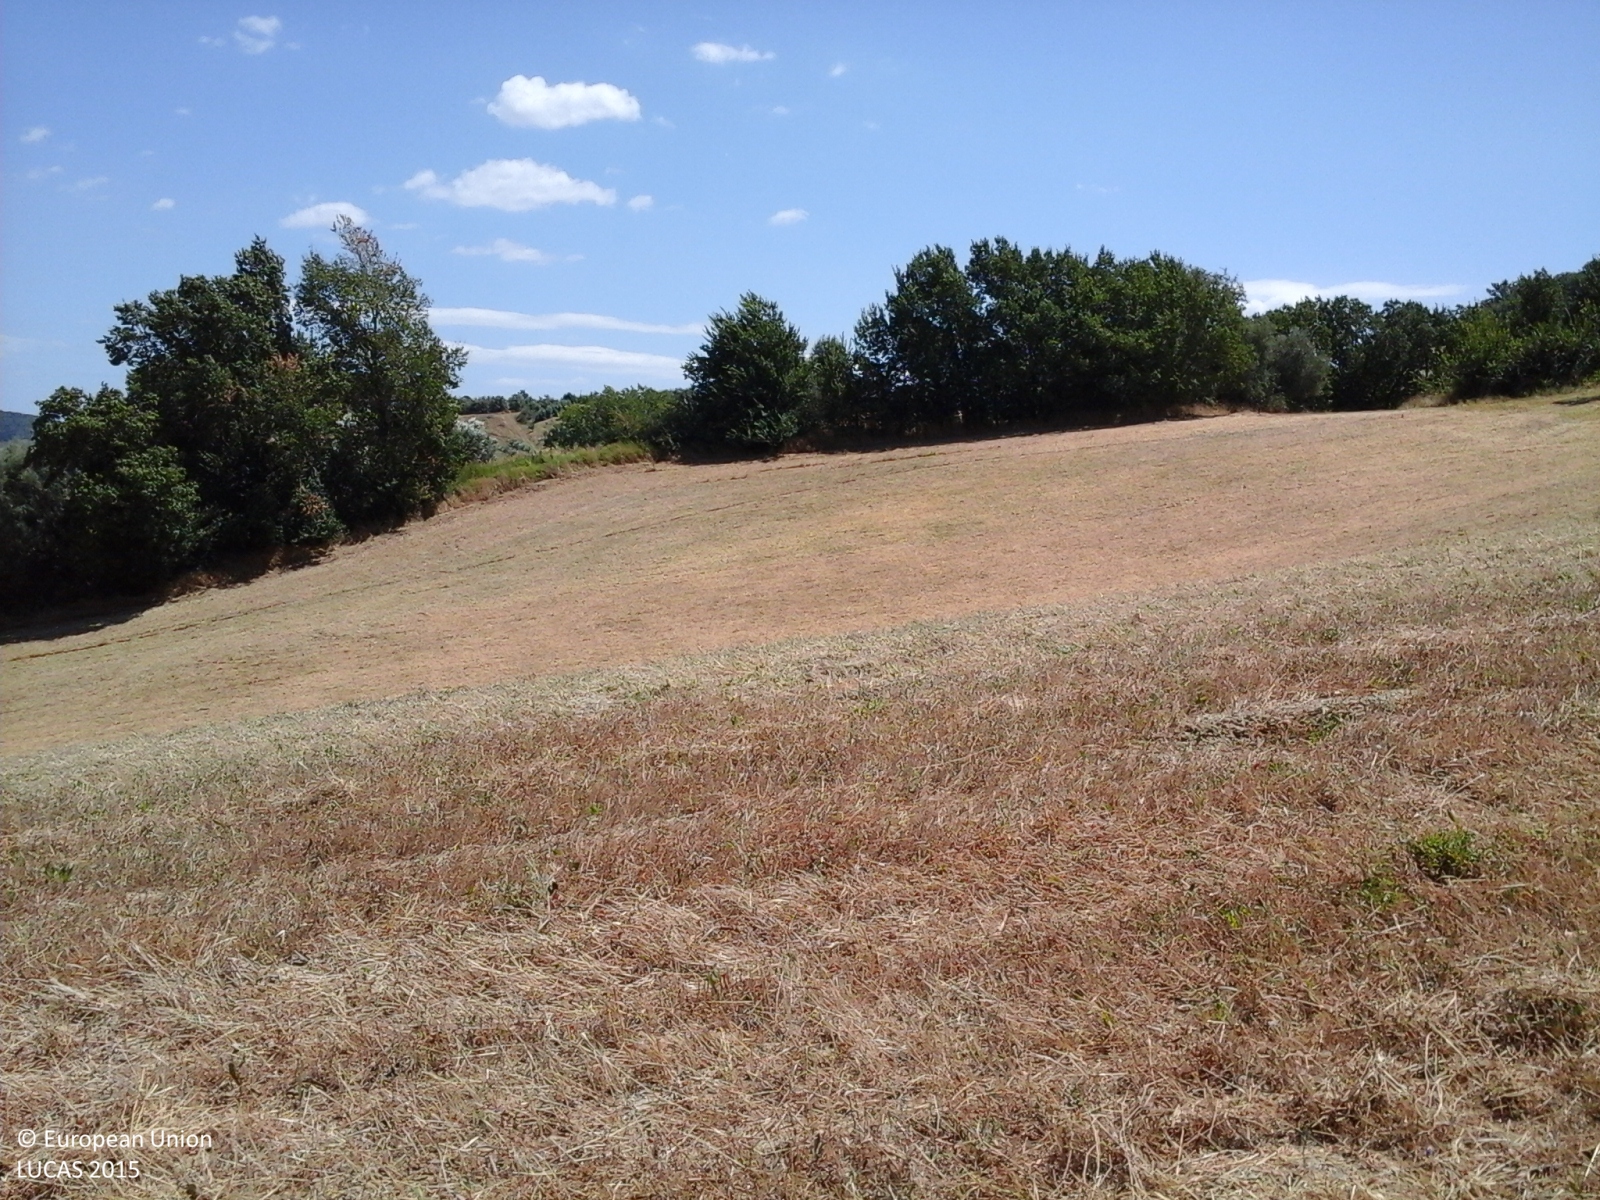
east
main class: Woodland
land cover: Broadleaved woodland
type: thermophilous deciduous forest
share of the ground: > 75 %
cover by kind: broadleaved forest trees 100 %
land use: Forestry
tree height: > 5 m
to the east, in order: Broadleaved woodland; Grassland without tree/shrub cover; Broadleaved woodland; Spontaneously vegetated surfaces; Tracks; Spontaneously vegetated surfaces
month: July
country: IT
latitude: 43.8303
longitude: 12.6176
